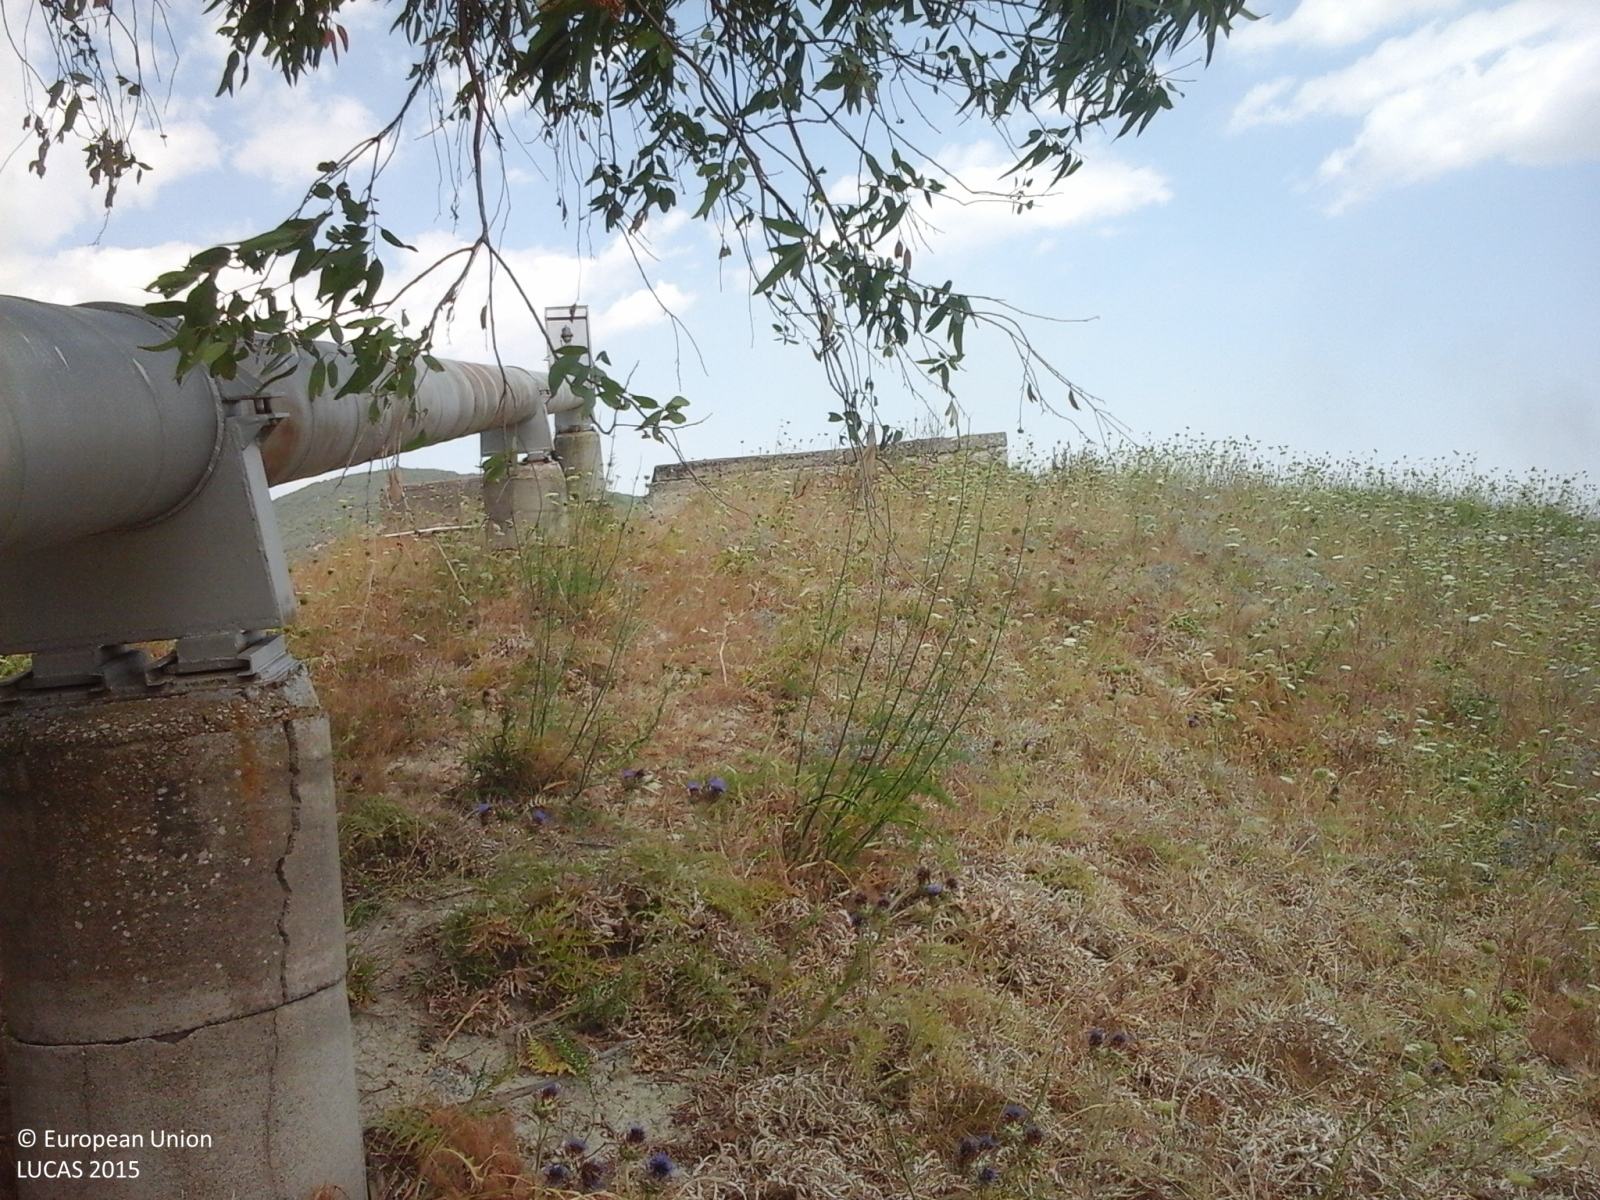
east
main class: Grassland
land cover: Grassland without tree/shrub cover
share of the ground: > 75 %
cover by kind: herbaceous plants 100 %
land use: Abandoned areas
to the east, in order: Grassland without tree/shrub cover; Ditches and canals; Grassland without tree/shrub cover
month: July
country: IT
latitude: 37.5916
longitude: 13.5184
